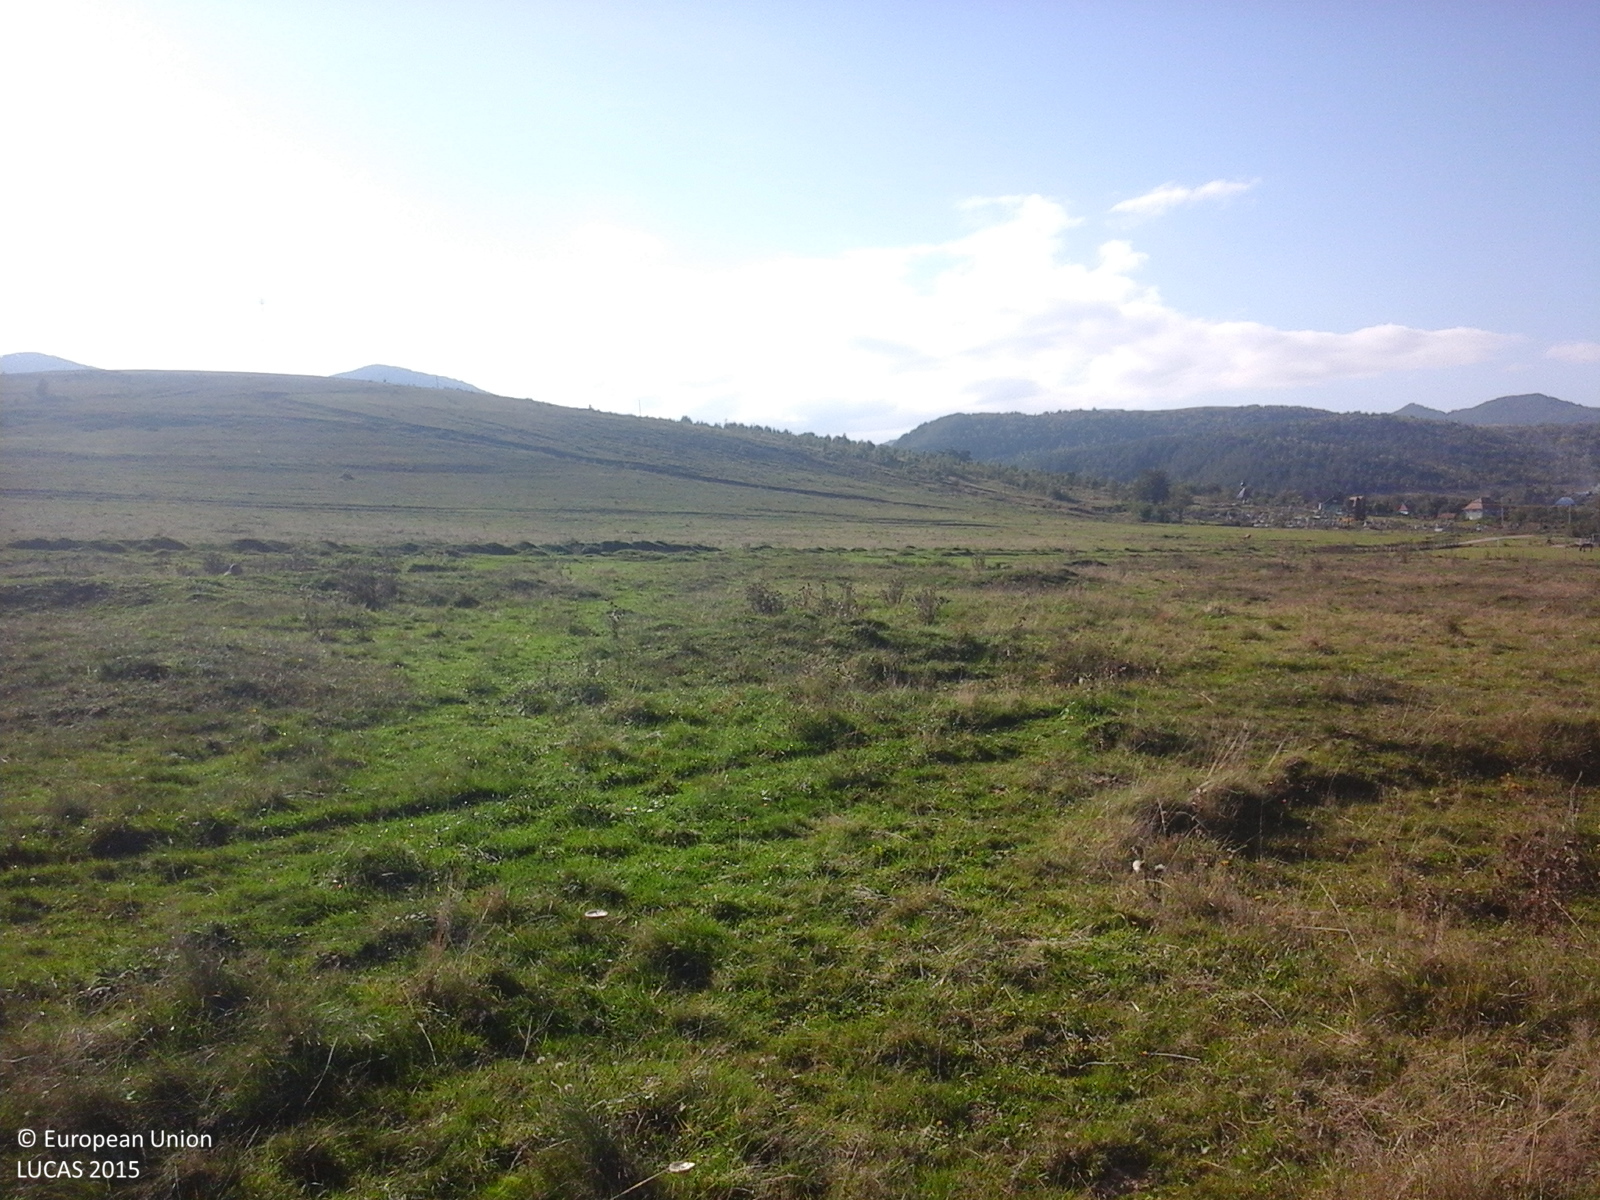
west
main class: Grassland
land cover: Grassland without tree/shrub cover
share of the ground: > 75 %
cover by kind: herbaceous plants 100 %
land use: Agriculture (excluding fallow land and kitchen gardens)
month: October
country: RO
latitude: 46.5716
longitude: 23.4672
